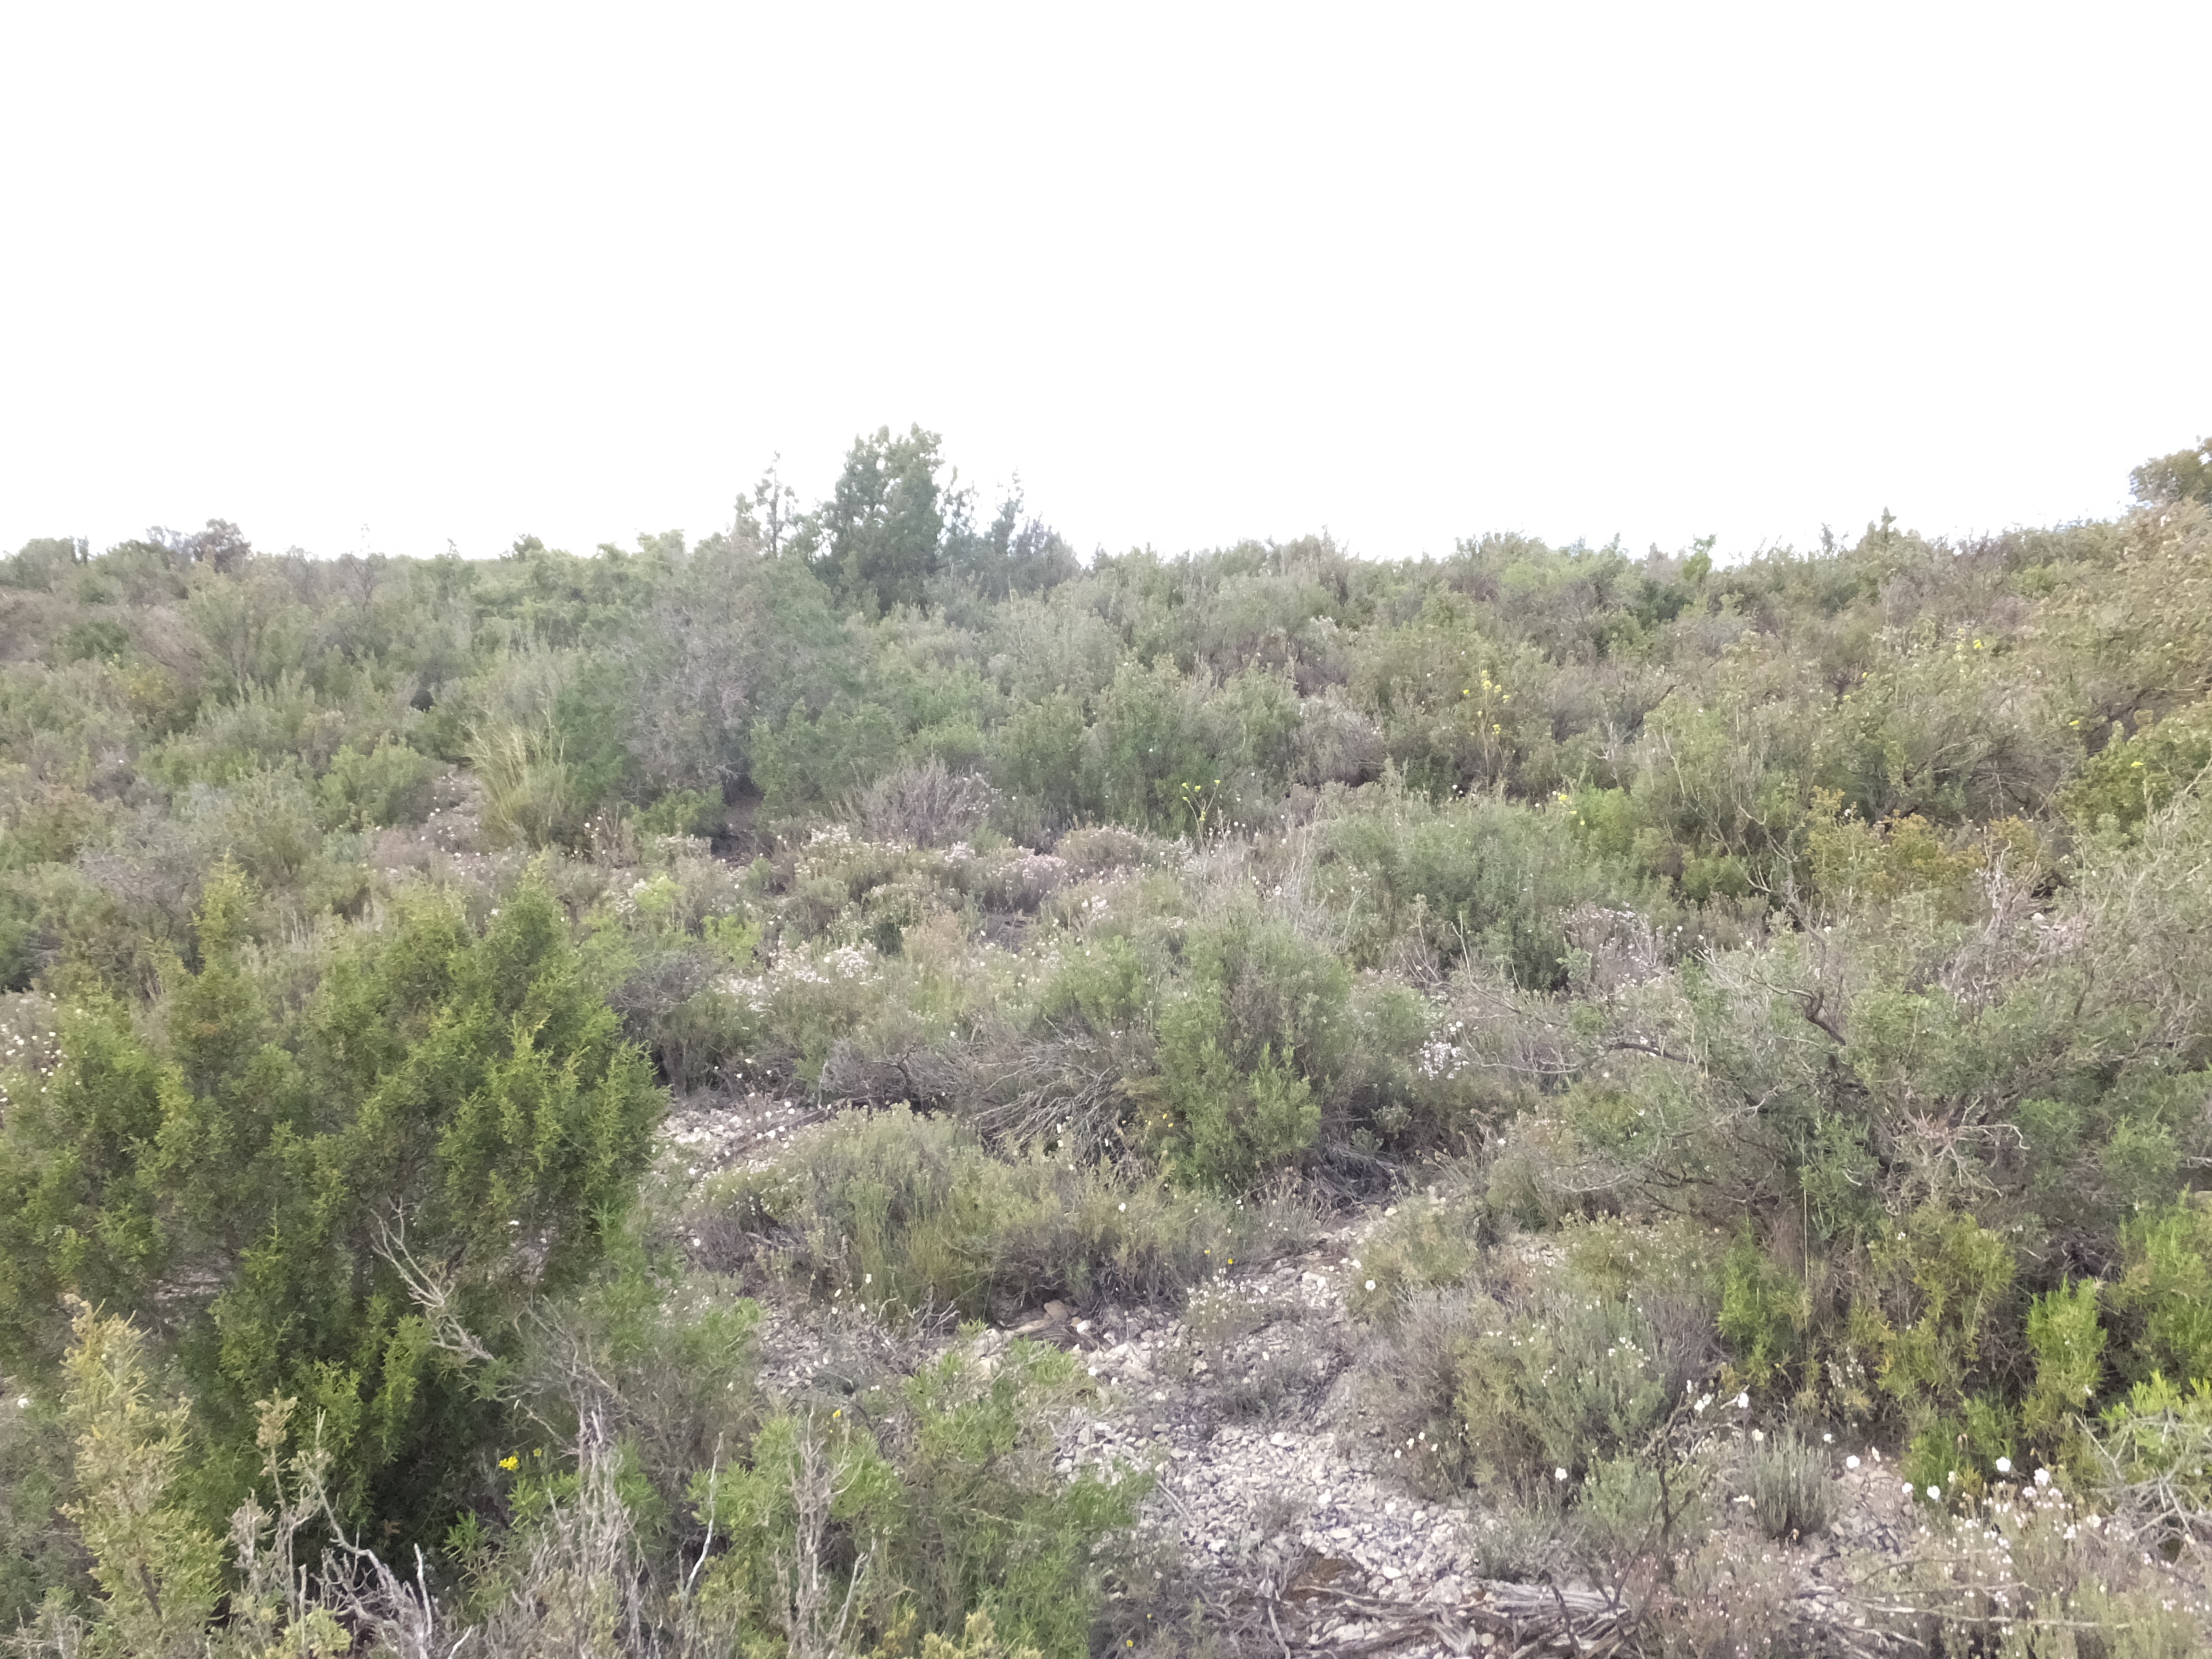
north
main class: Shrubland
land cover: Shrubland with sparse tree cover
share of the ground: > 75 %
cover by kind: shrubs 95 %, coniferous forest trees 5 %
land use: Semi-natural and natural areas not in use
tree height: < 5 m
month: April
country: ES
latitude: 41.6357
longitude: -0.3055
